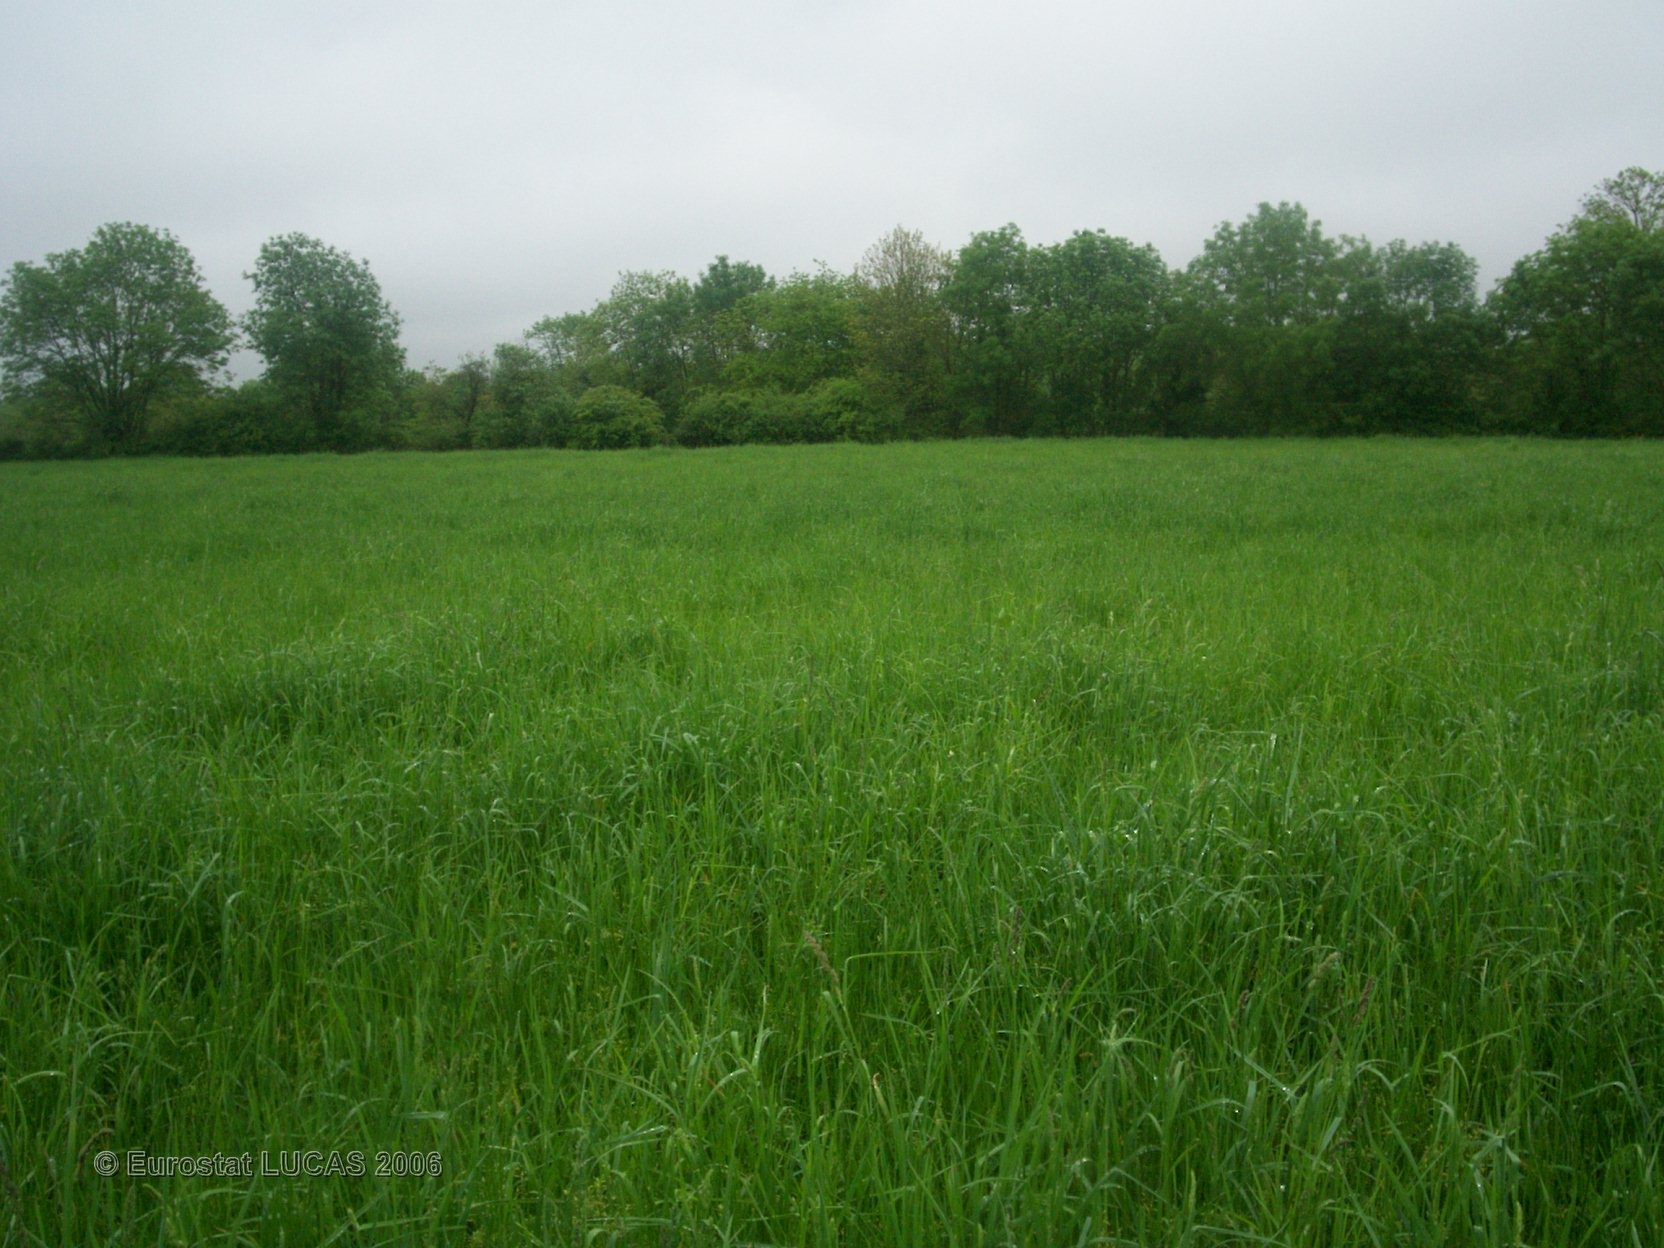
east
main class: Grassland
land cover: Grassland without tree/shrub cover
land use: Agriculture (excluding fallow land and kitchen gardens)
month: April
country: FR
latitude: 46.7191
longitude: -0.3484
